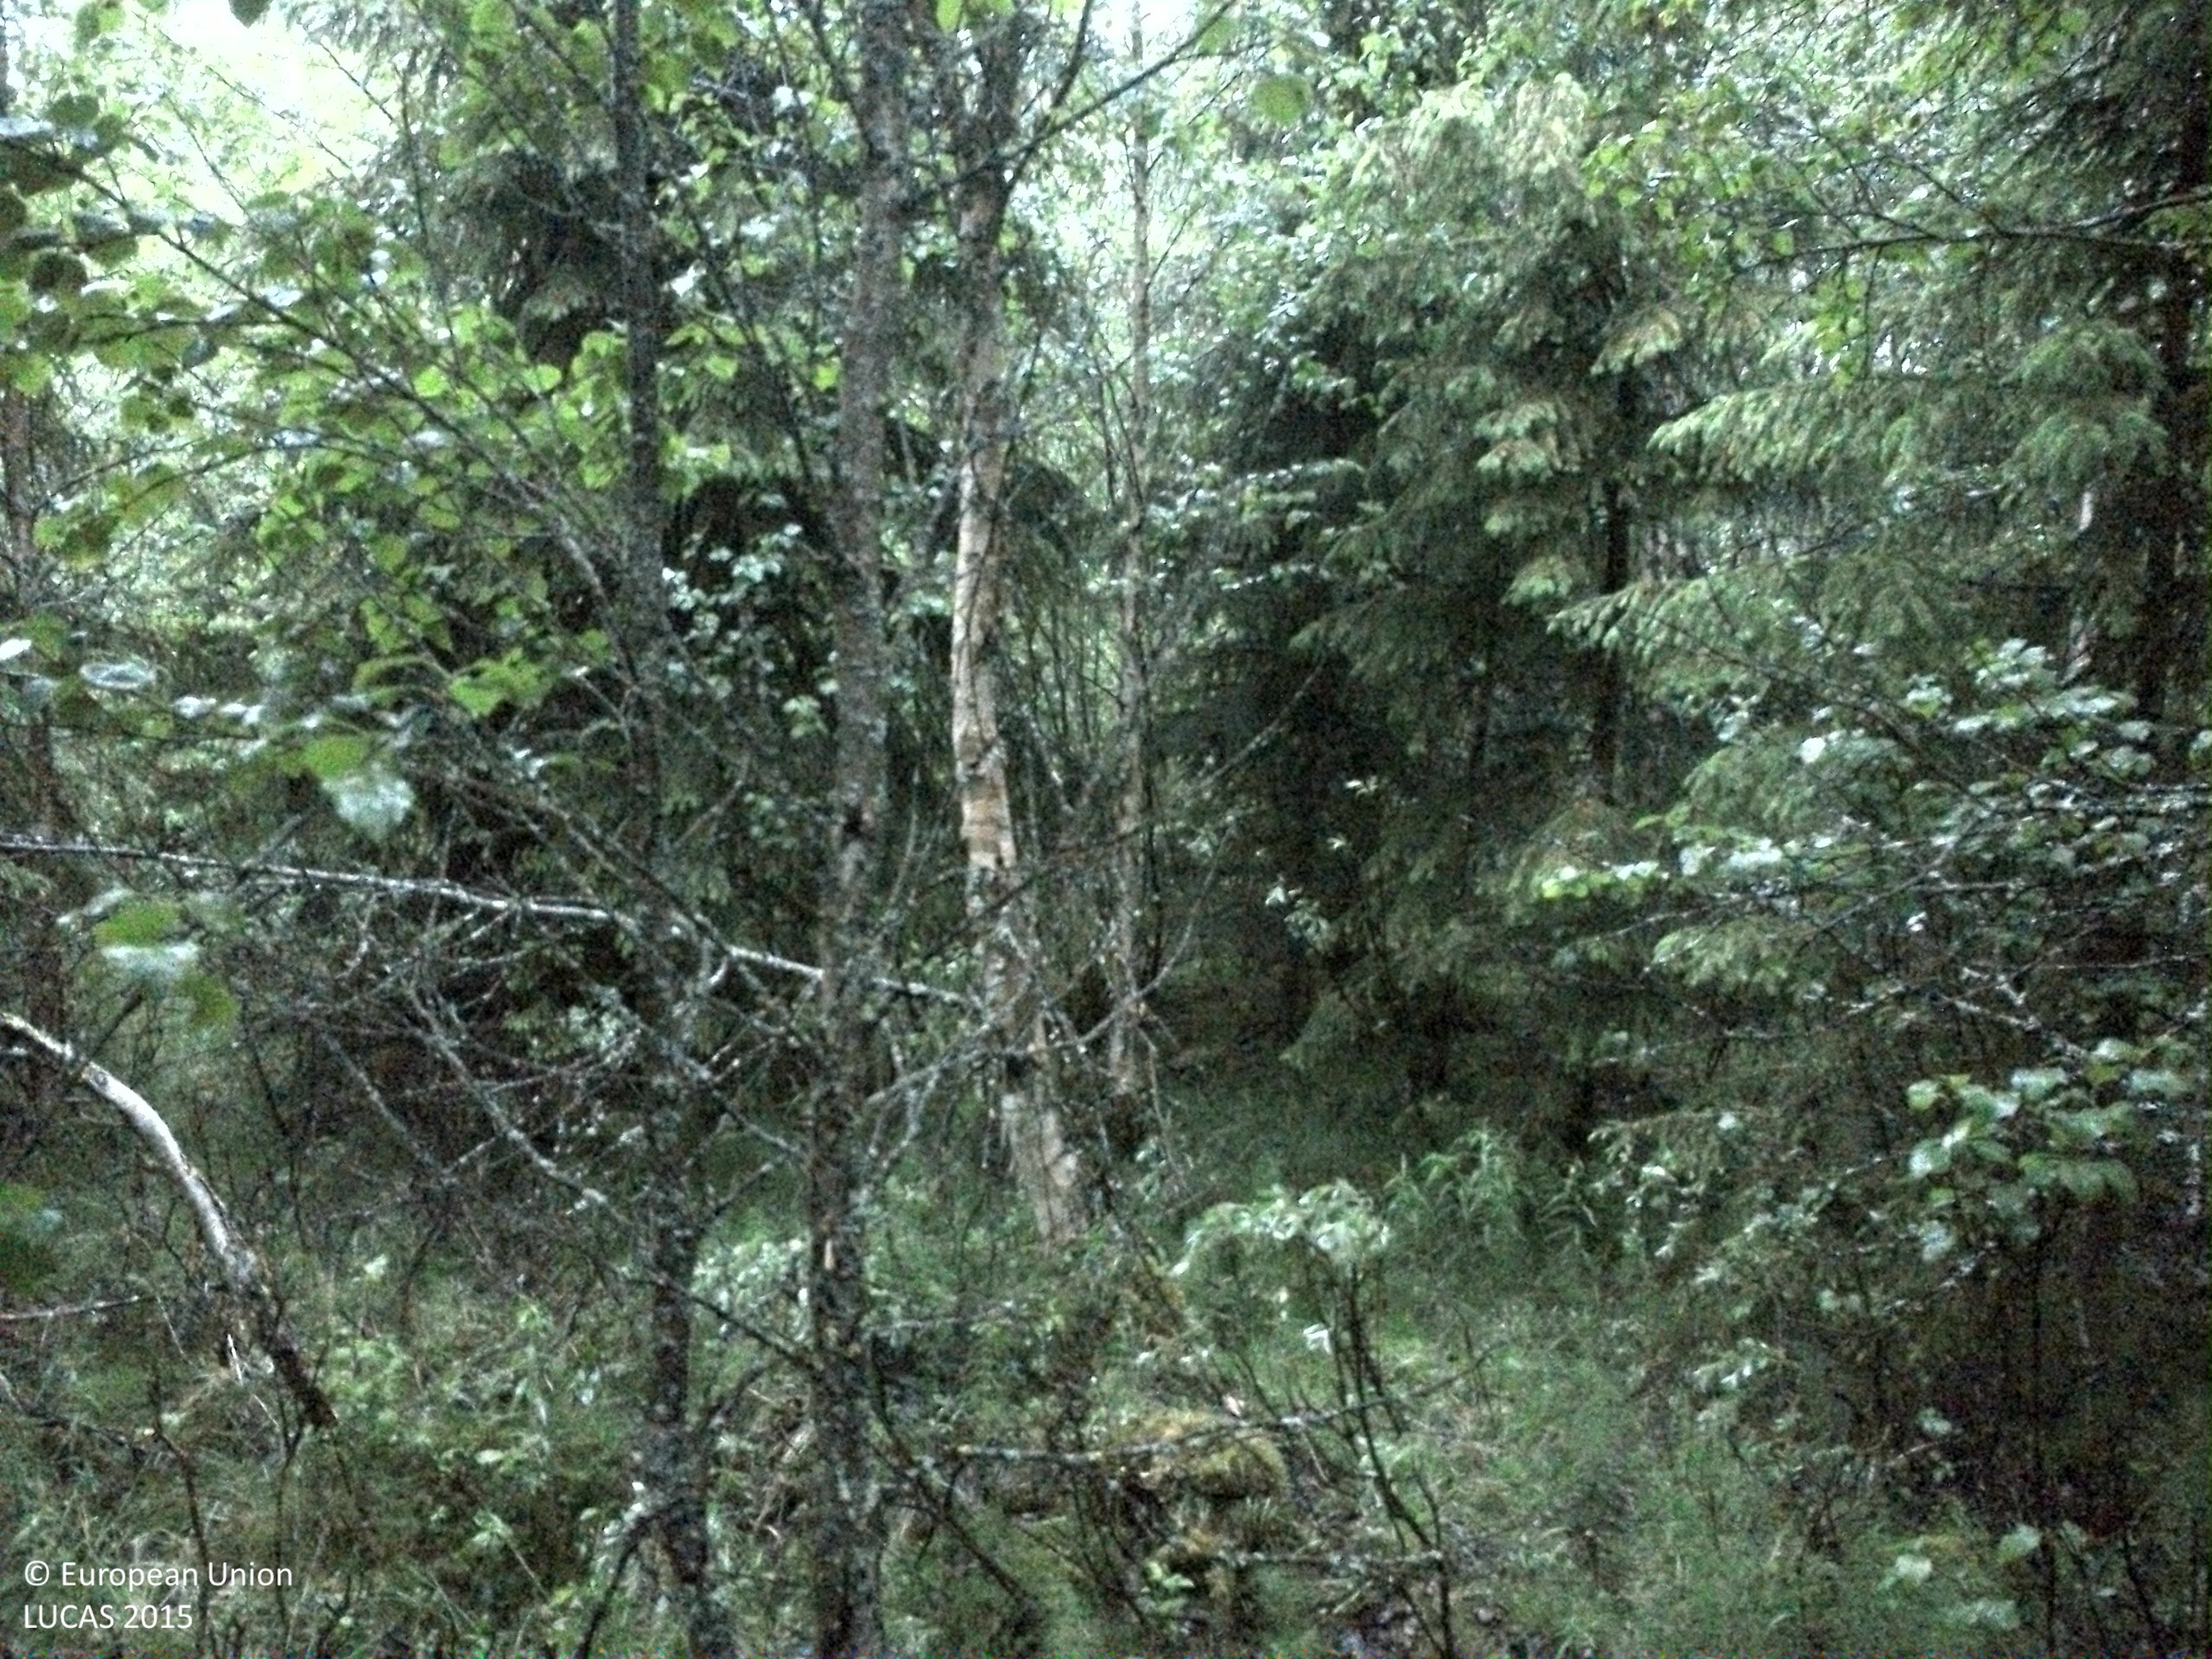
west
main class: Woodland
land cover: Other mixed woodland
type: boreal forest
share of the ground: > 75 %
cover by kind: broadleaved forest trees 45 %, coniferous forest trees 40 %, herbaceous plants 10 %, lichens and mosses 5 %
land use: Forestry
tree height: > 5 m
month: July
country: SE
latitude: 64.4784
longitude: 16.1468
